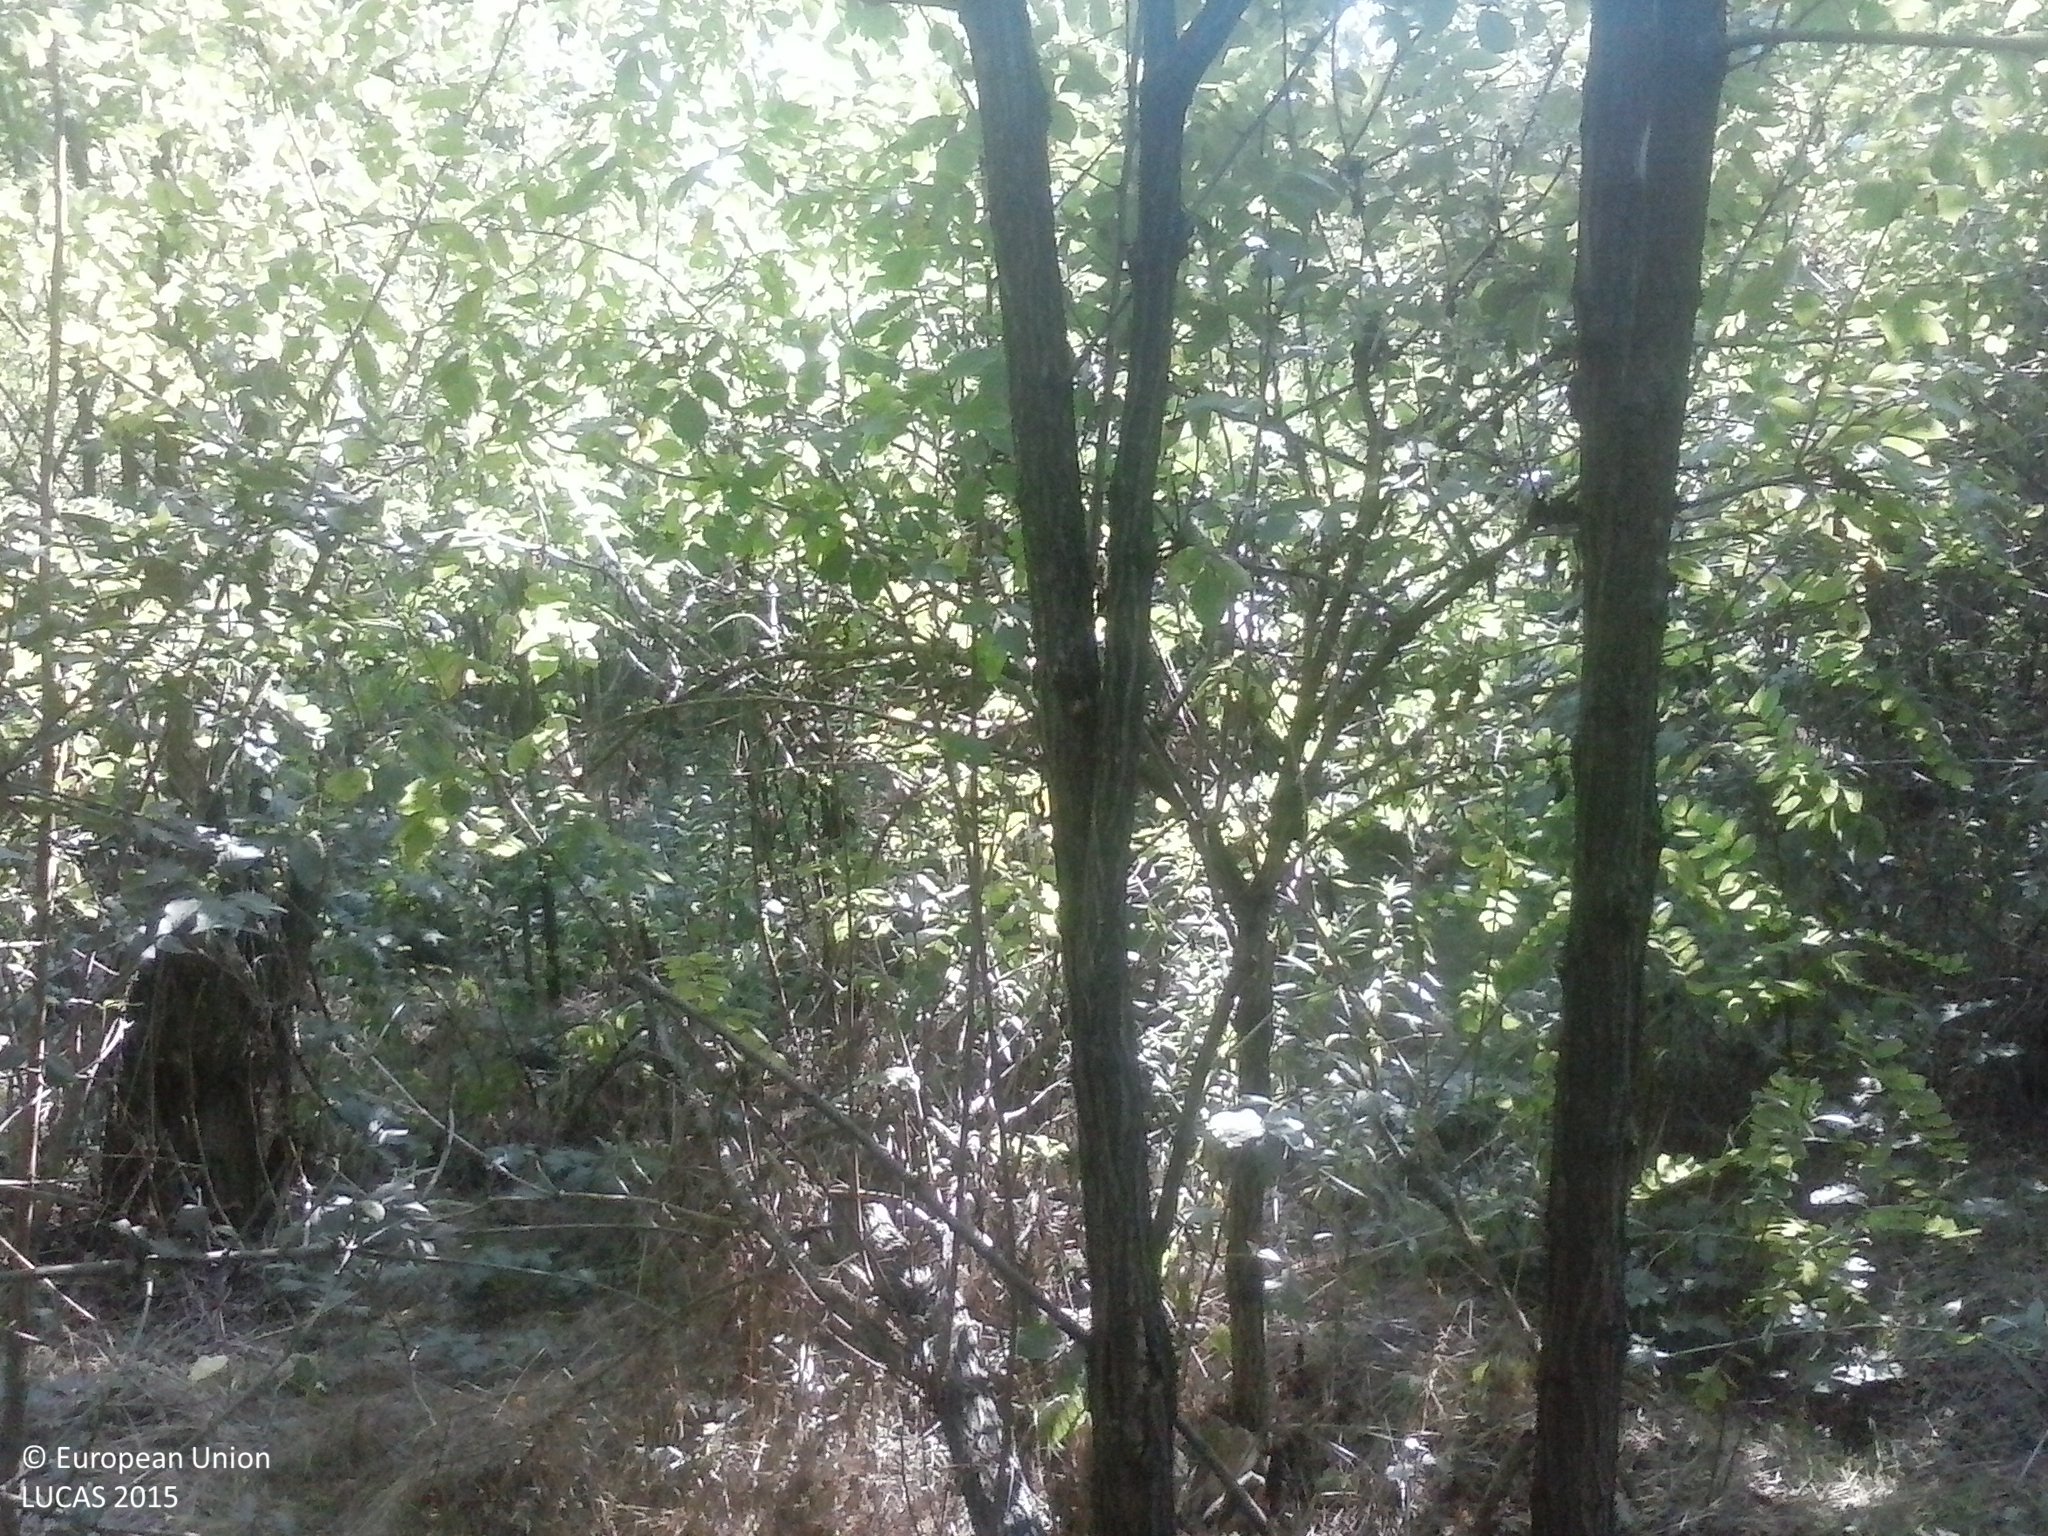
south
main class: Shrubland
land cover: Shrubland with sparse tree cover
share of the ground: > 75 %
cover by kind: shrubs 90 %, broadleaved forest trees 5 %, herbaceous plants 5 %
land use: Abandoned areas
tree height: < 5 m
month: August
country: HU
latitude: 46.0020
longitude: 17.6873
